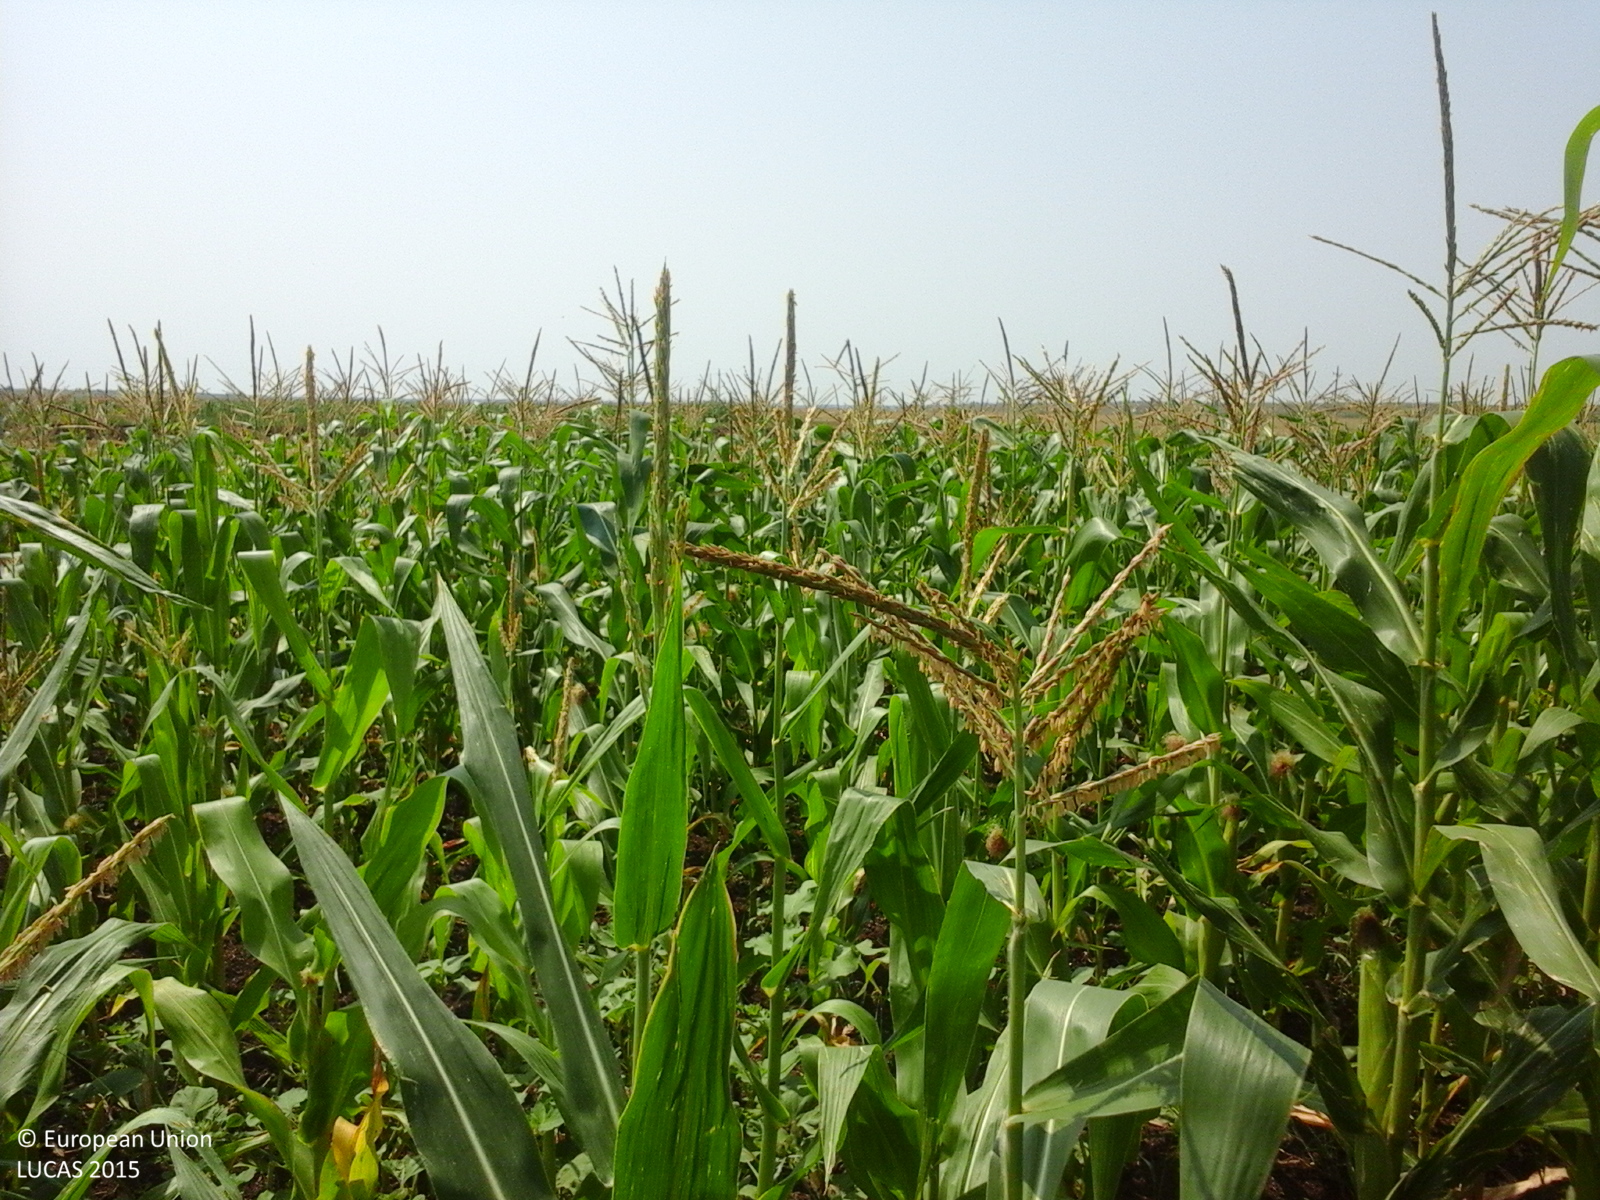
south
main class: Cropland
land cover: Maize
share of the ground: > 75 %
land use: Agriculture (excluding fallow land and kitchen gardens)
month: July
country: RO
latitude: 44.7908
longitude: 26.5649
